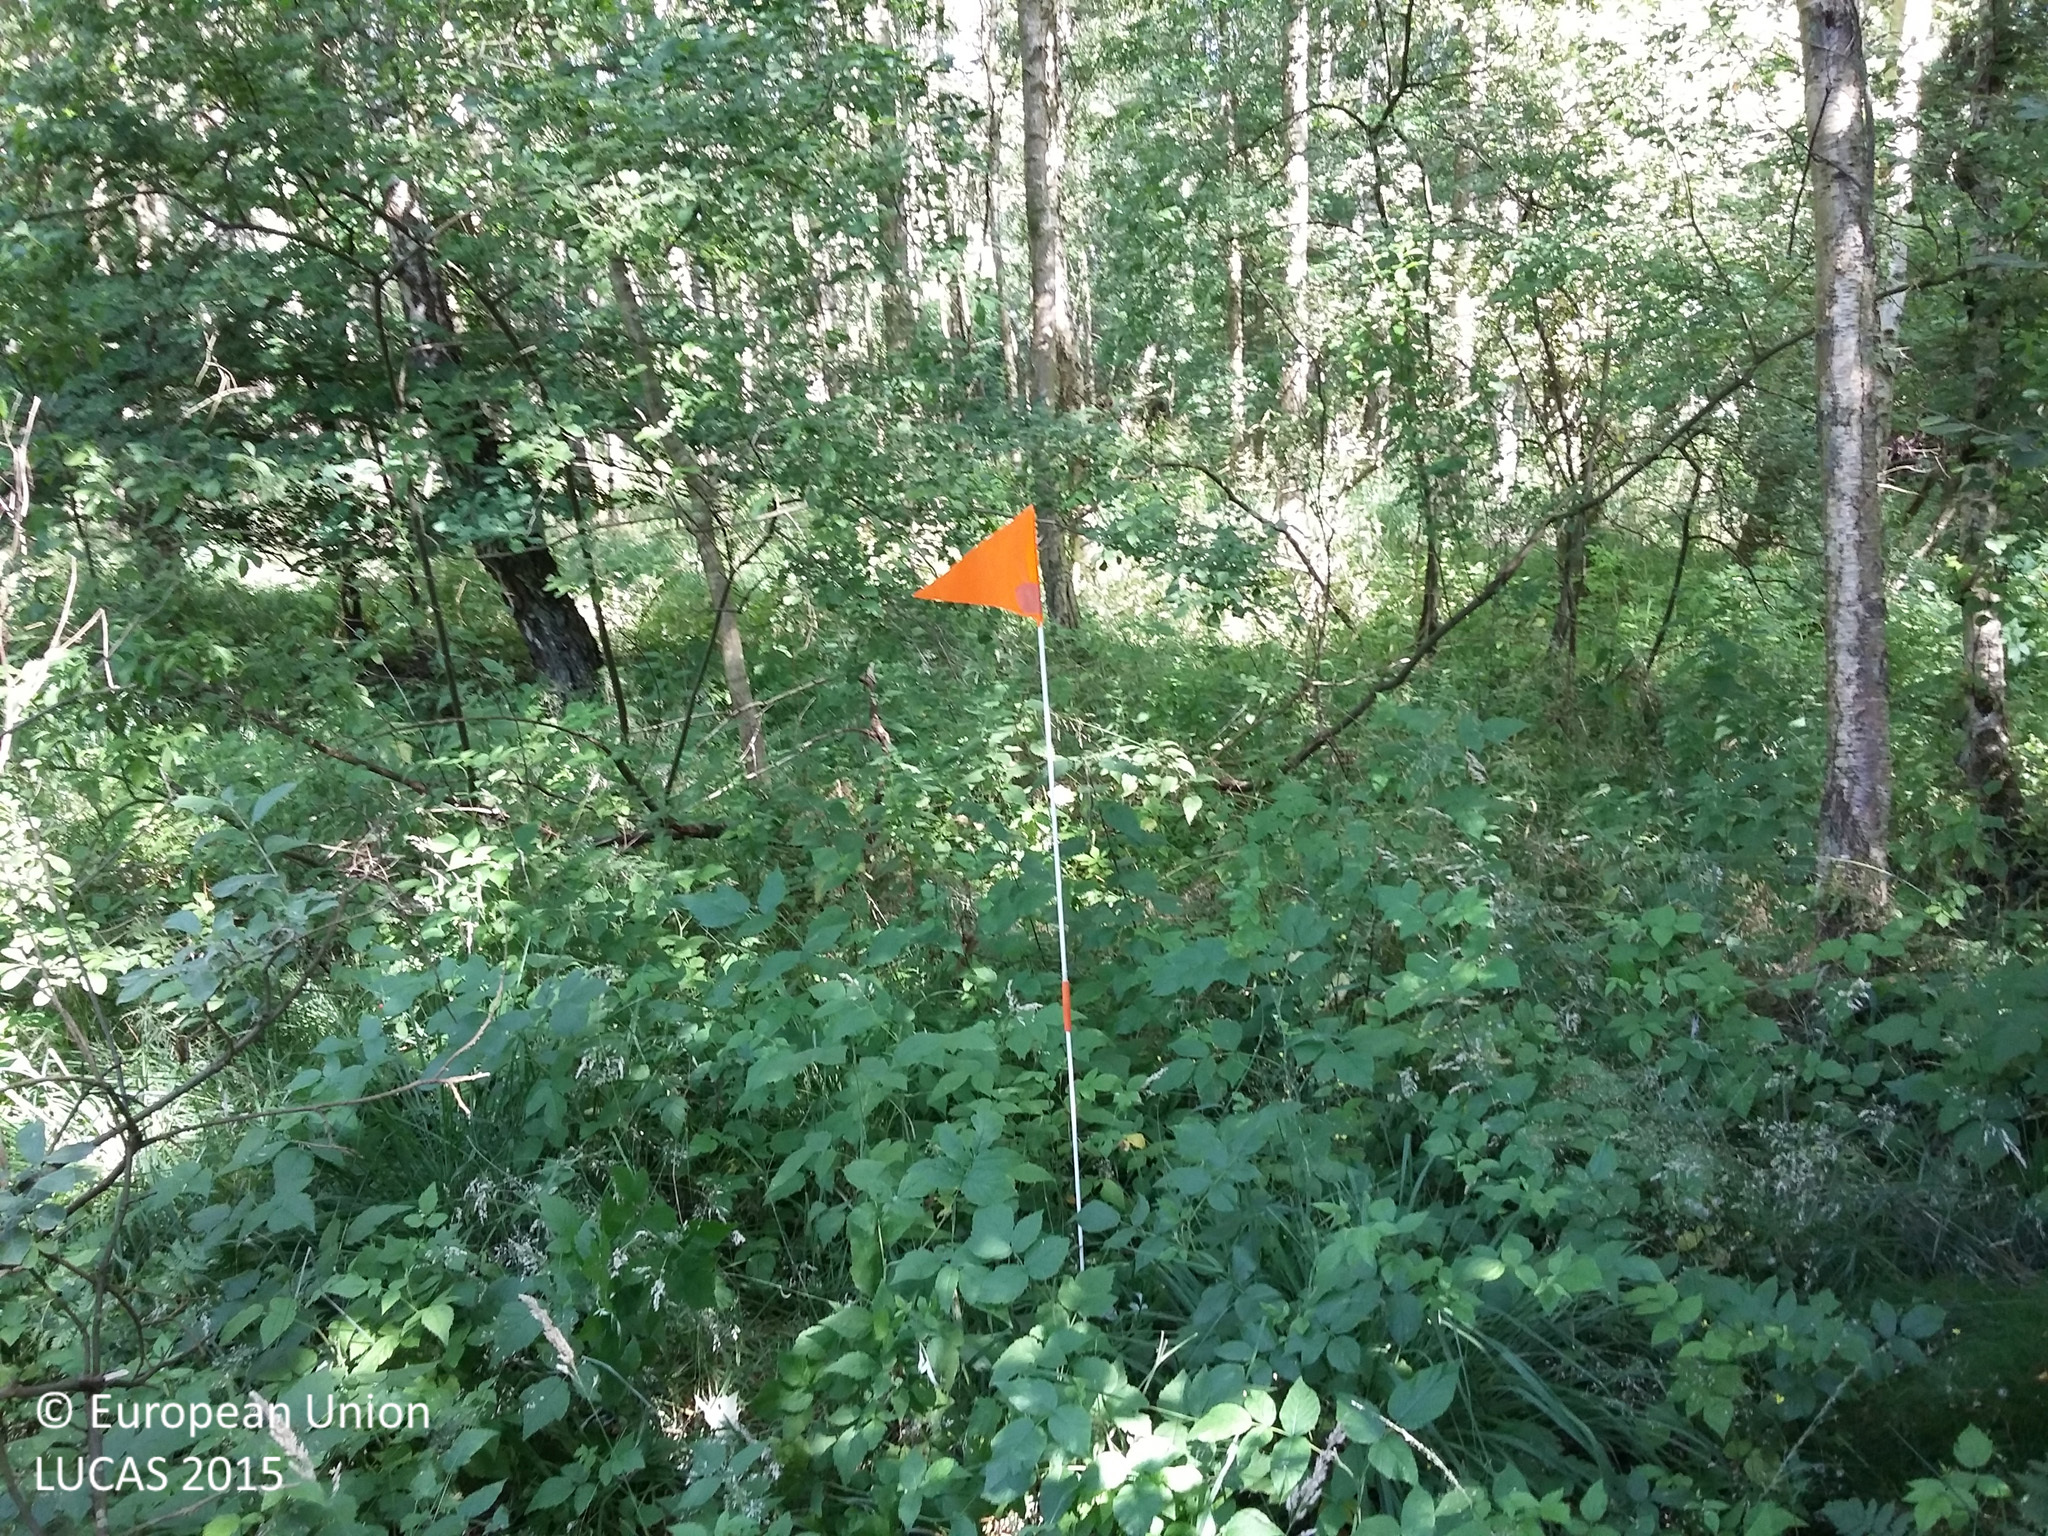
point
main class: Woodland
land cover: Broadleaved woodland
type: acidophilous oak and oak-birch forest
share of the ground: > 75 %
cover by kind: broadleaved forest trees 70 %, herbaceous plants 20 %, shrubs 10 %
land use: Forestry
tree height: > 5 m
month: August
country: DK
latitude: 55.3124
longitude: 11.7790
